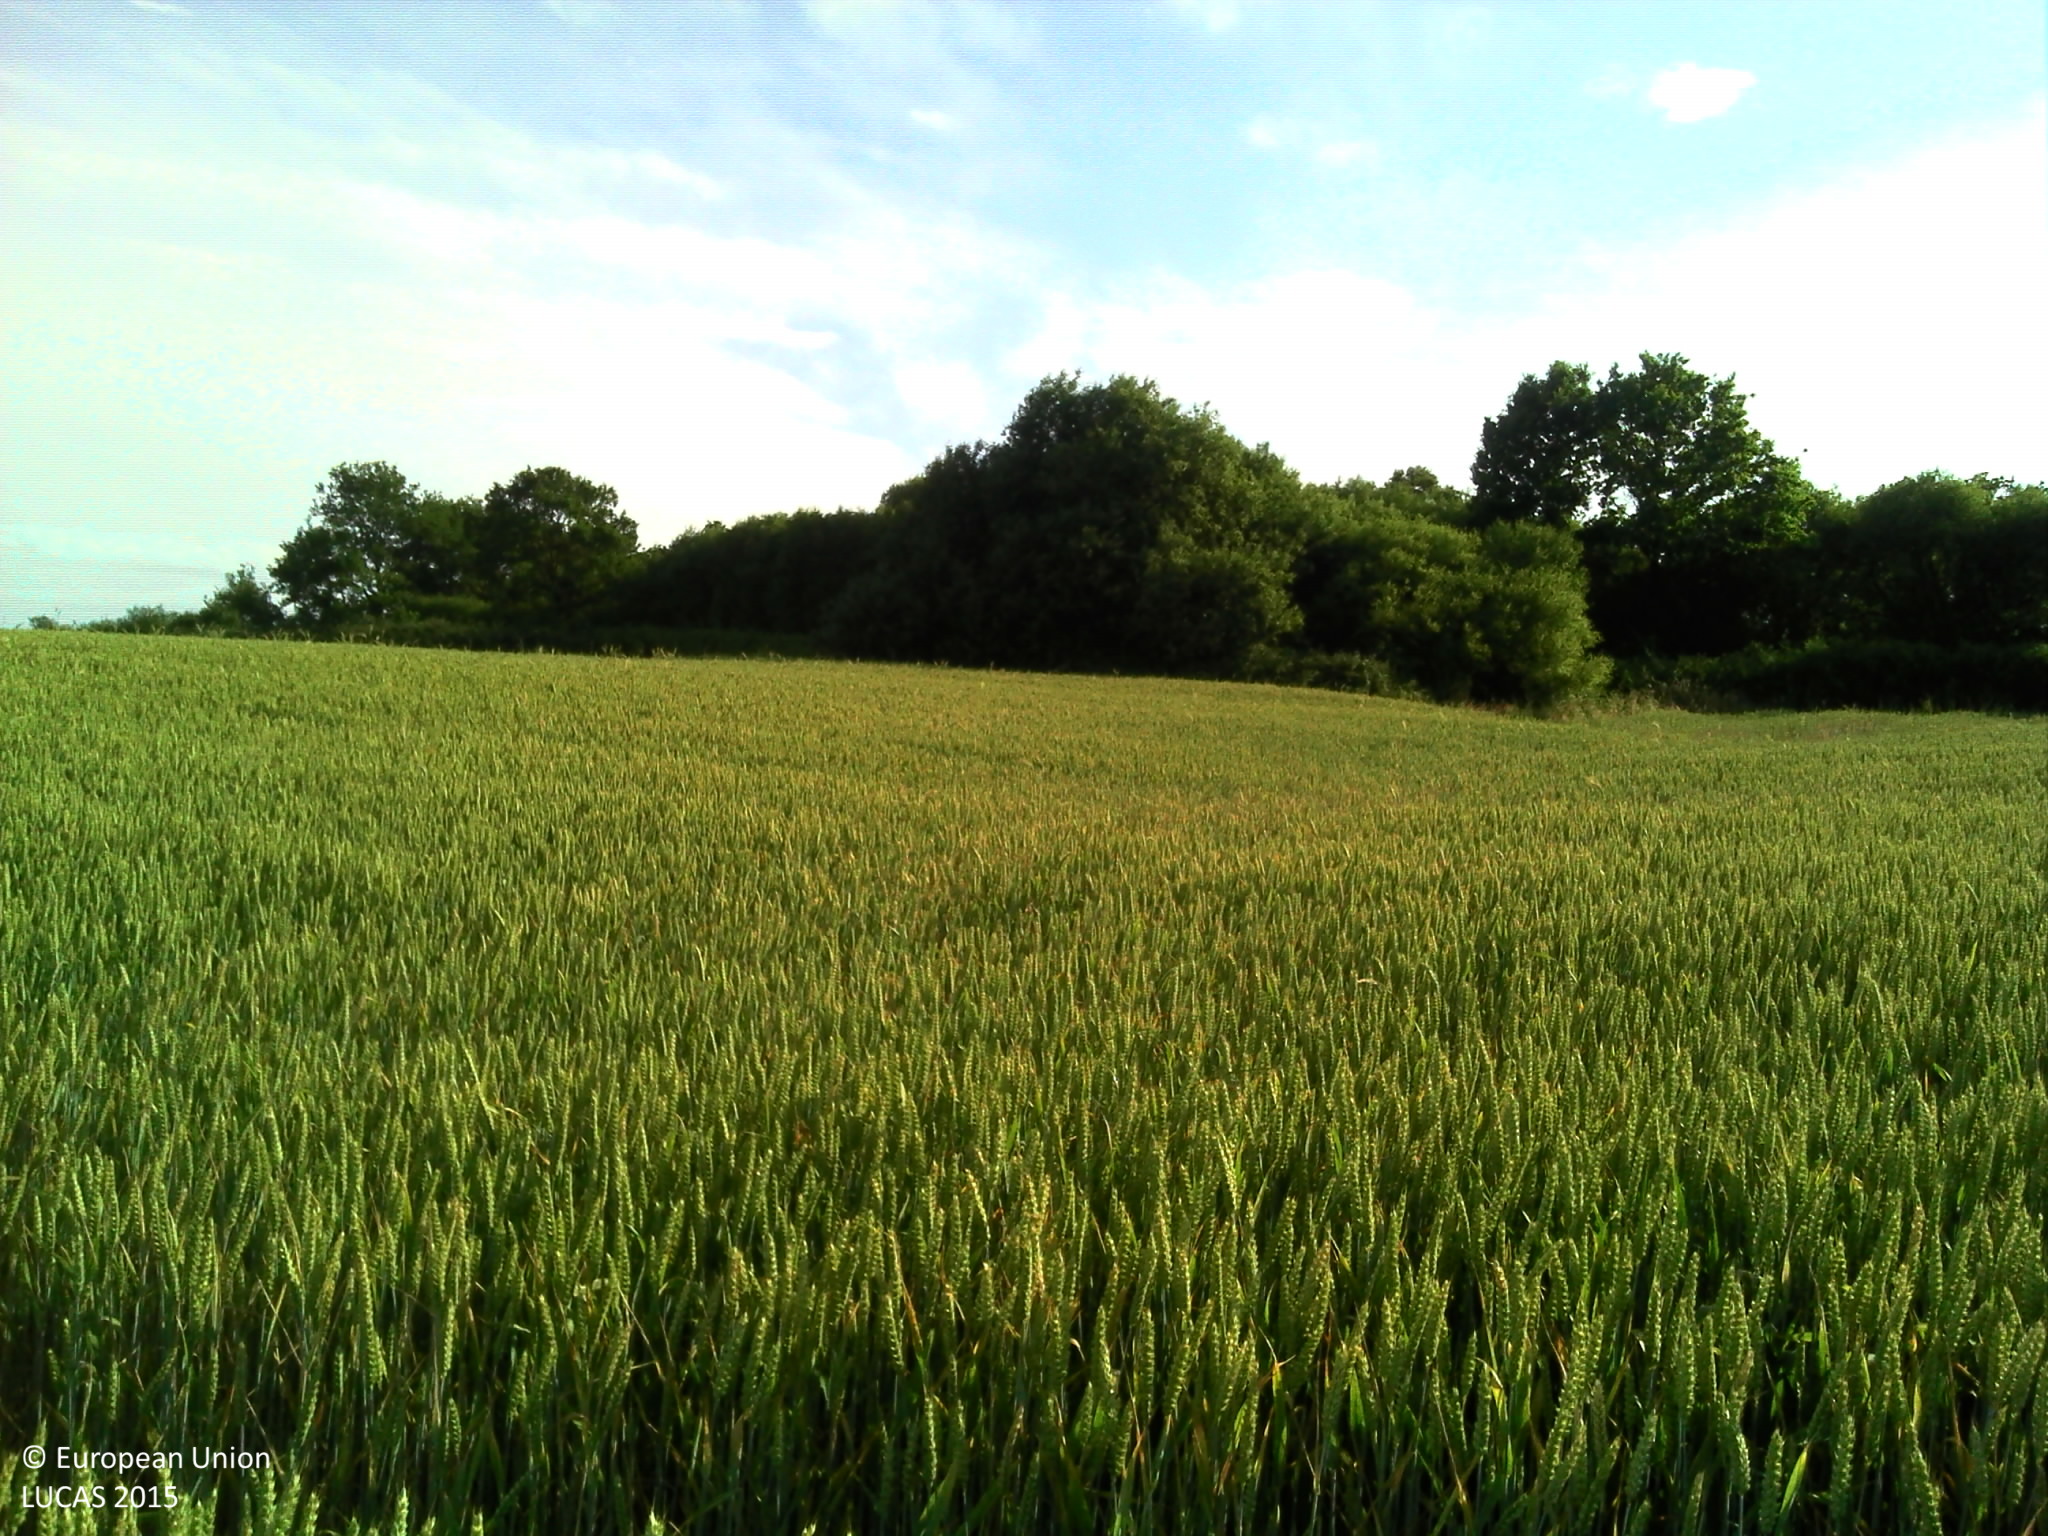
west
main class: Cropland
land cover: Common wheat
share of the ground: > 75 %
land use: Agriculture (excluding fallow land and kitchen gardens)
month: June
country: FR
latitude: 46.9028
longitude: -1.7395
